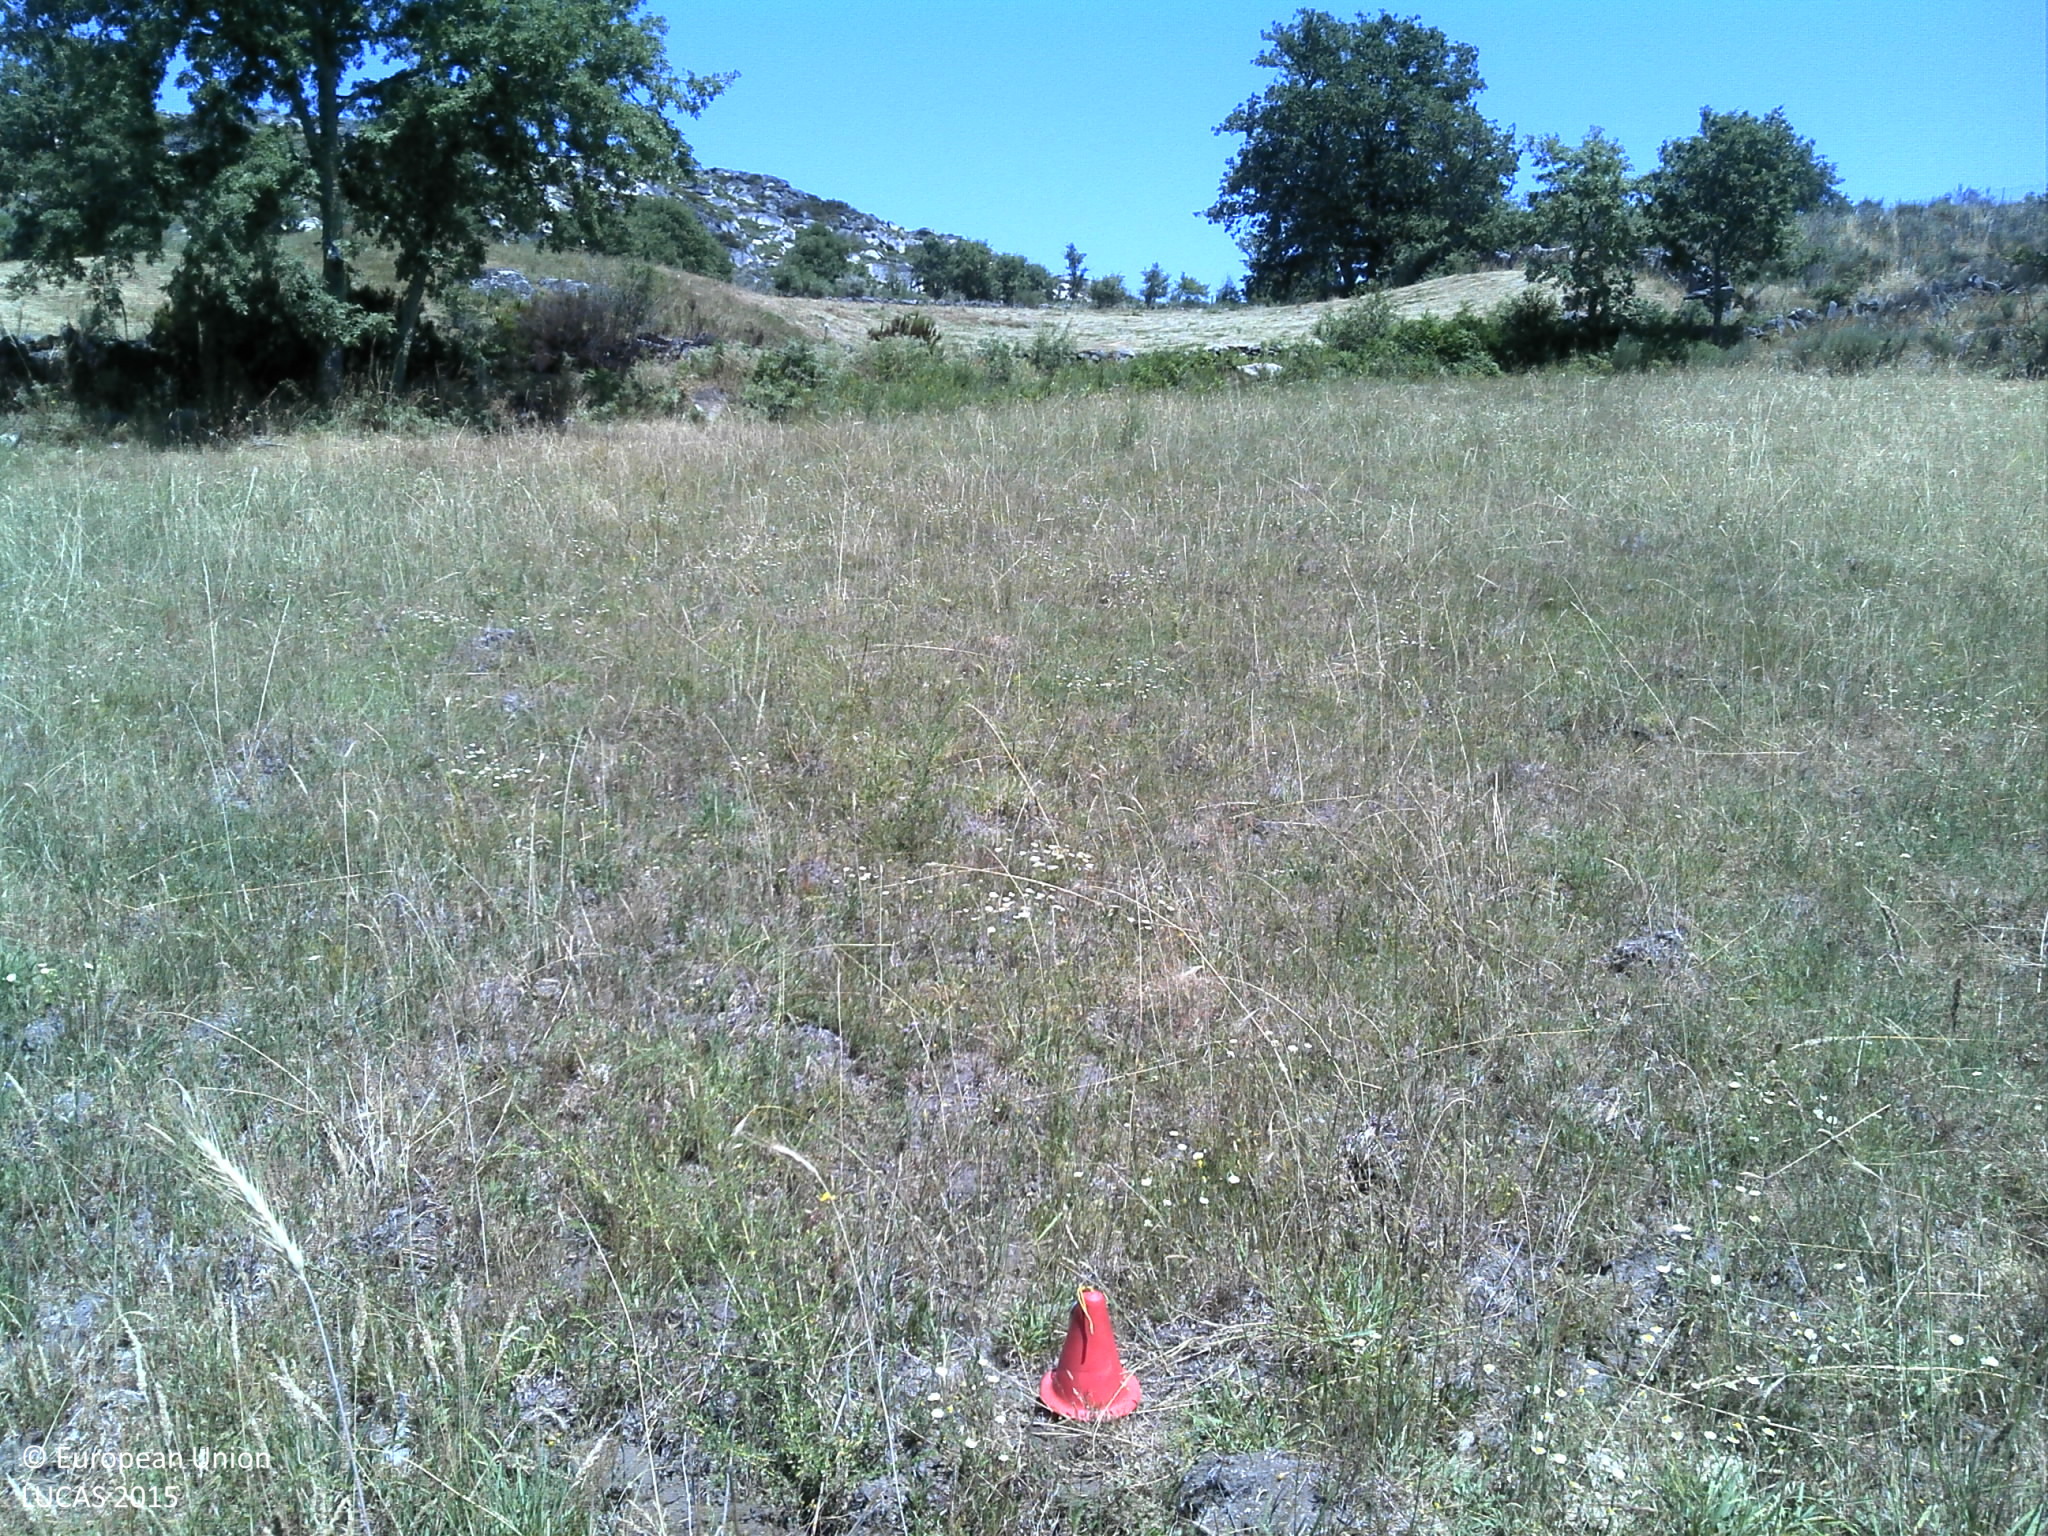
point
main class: Grassland
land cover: Grassland without tree/shrub cover
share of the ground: > 75 %
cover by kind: herbaceous plants 95 %, unconsolidated bare surface 5 %
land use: Agriculture (excluding fallow land and kitchen gardens)
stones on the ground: < 10 %
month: July
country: PT
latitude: 41.8089
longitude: -7.6496
